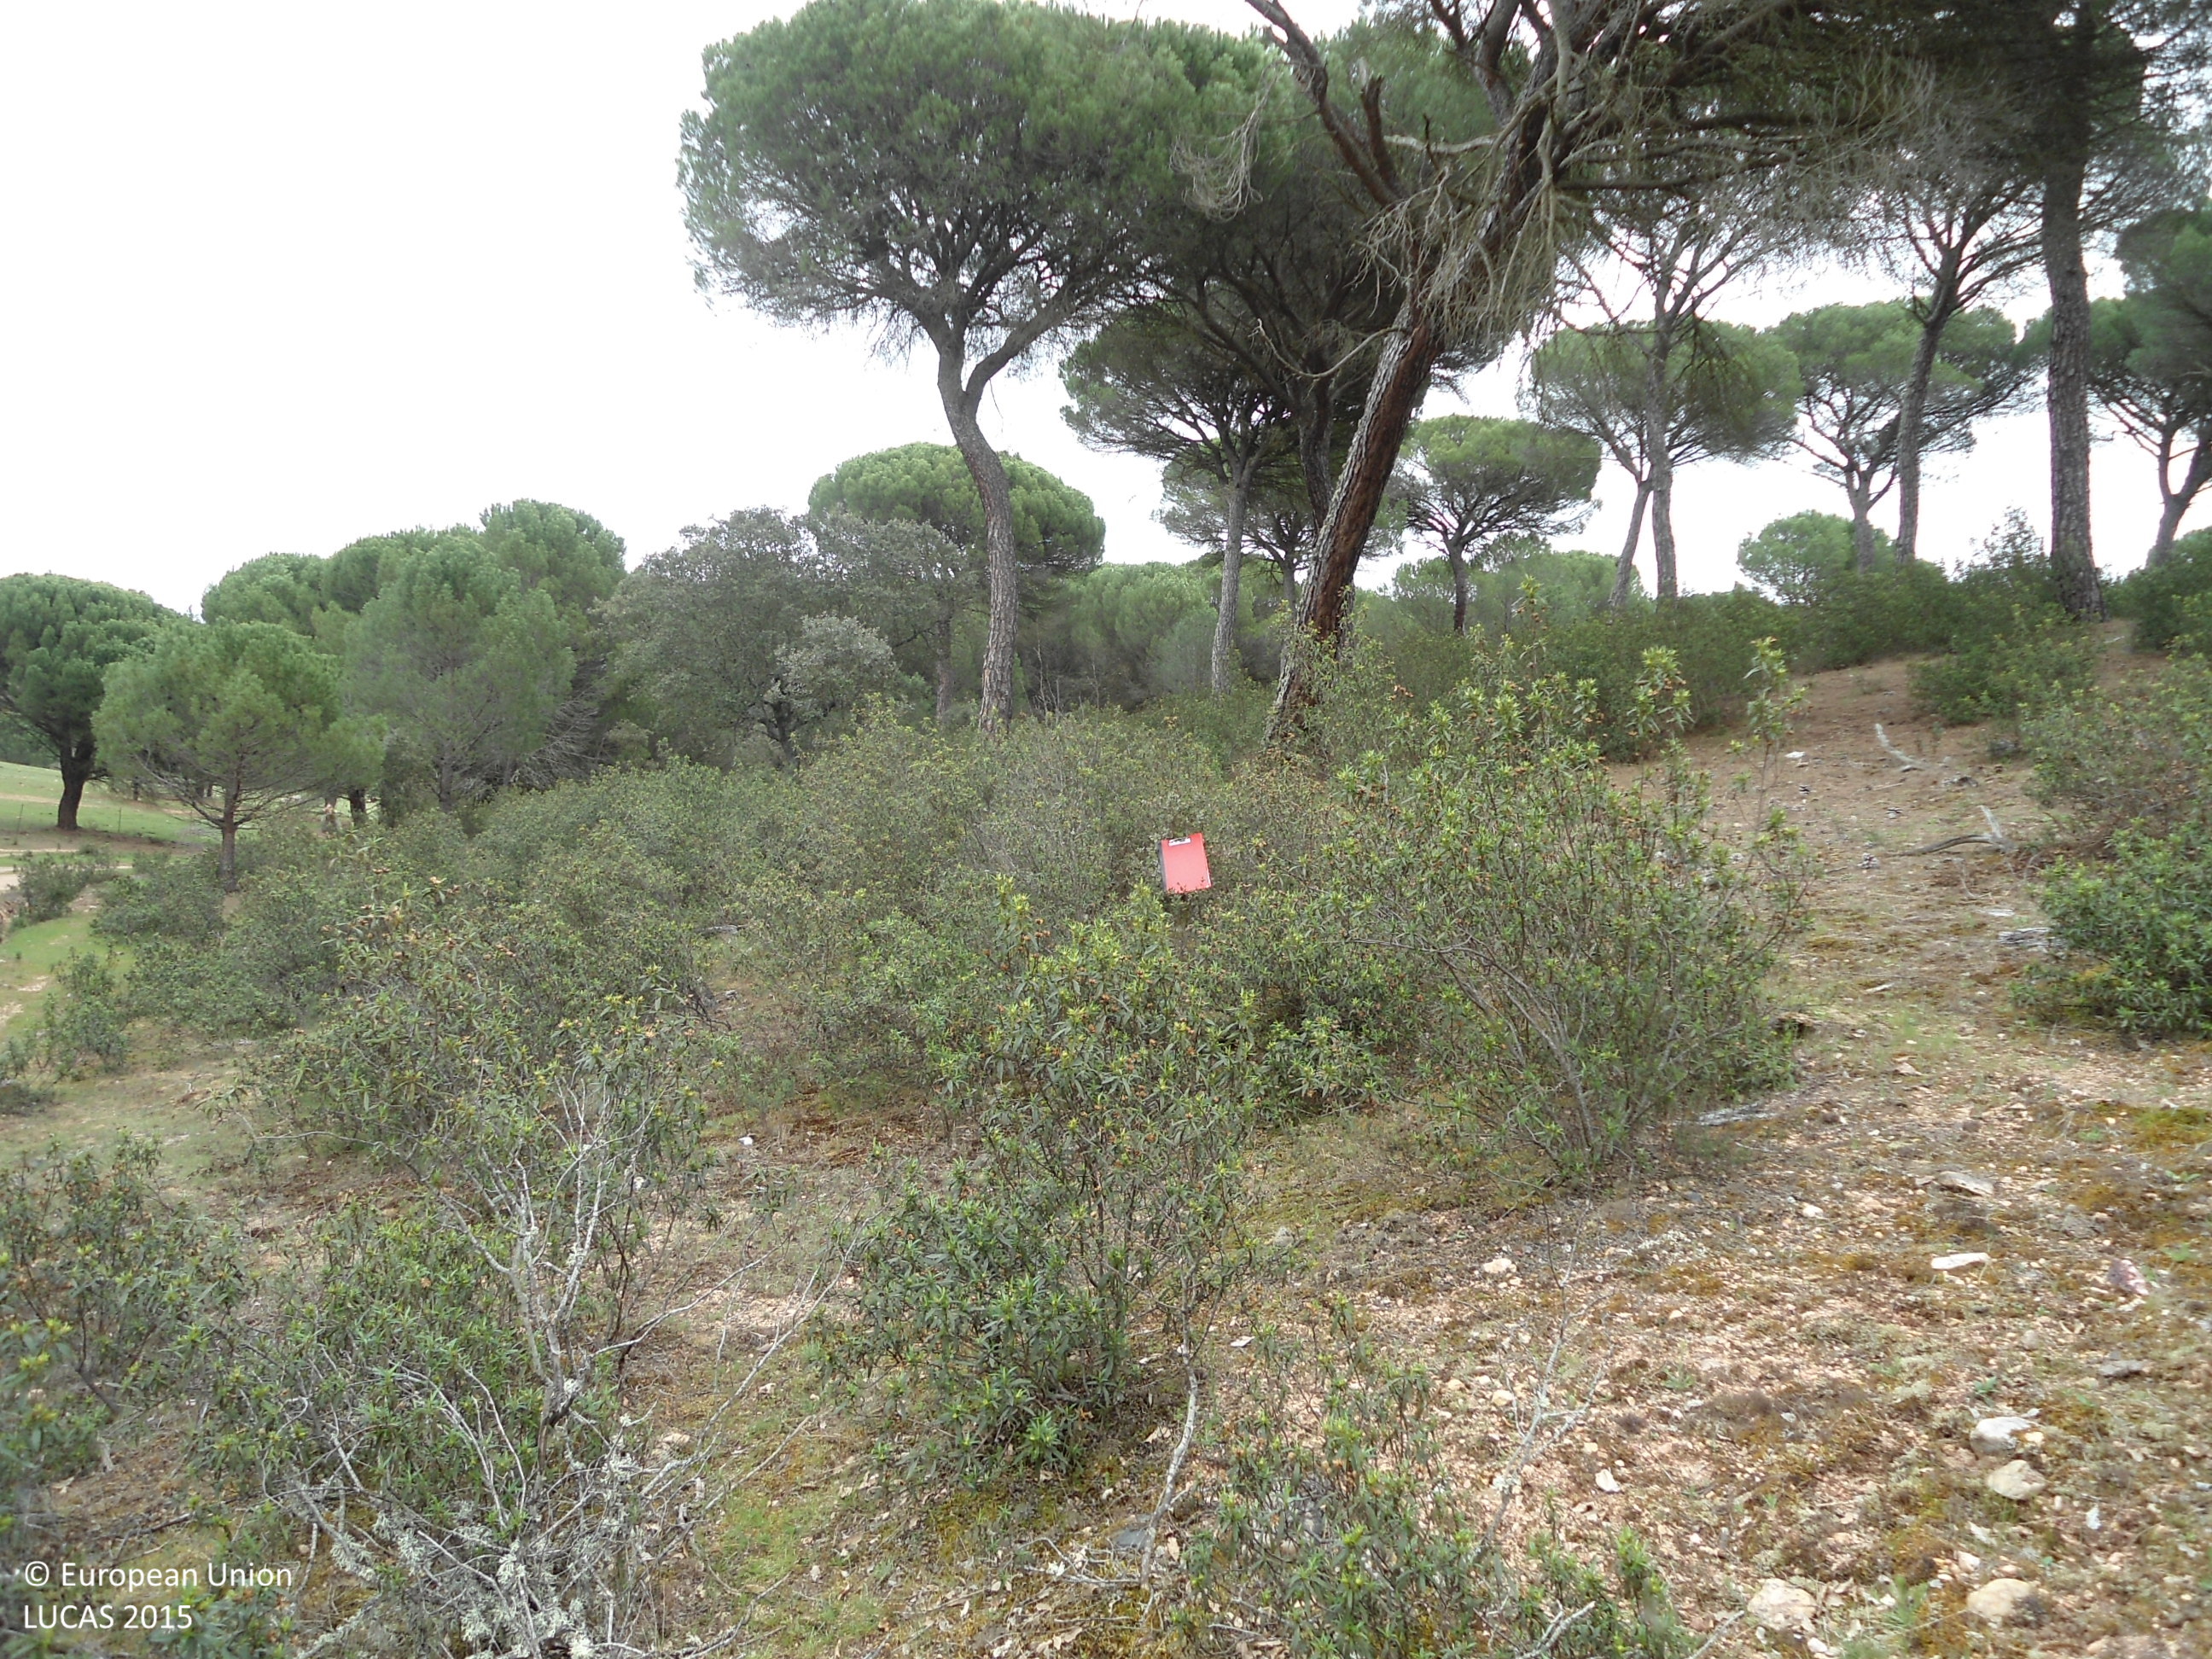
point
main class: Woodland
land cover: Pine dominated coniferous woodland
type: coniferous forest of the mediterranean region
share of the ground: > 75 %
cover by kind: coniferous forest trees 80 %, shrubs 10 %, herbaceous plants 10 %
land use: Agriculture (excluding fallow land and kitchen gardens)
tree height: > 5 m
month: April
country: ES
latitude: 41.5470
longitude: -5.8292
